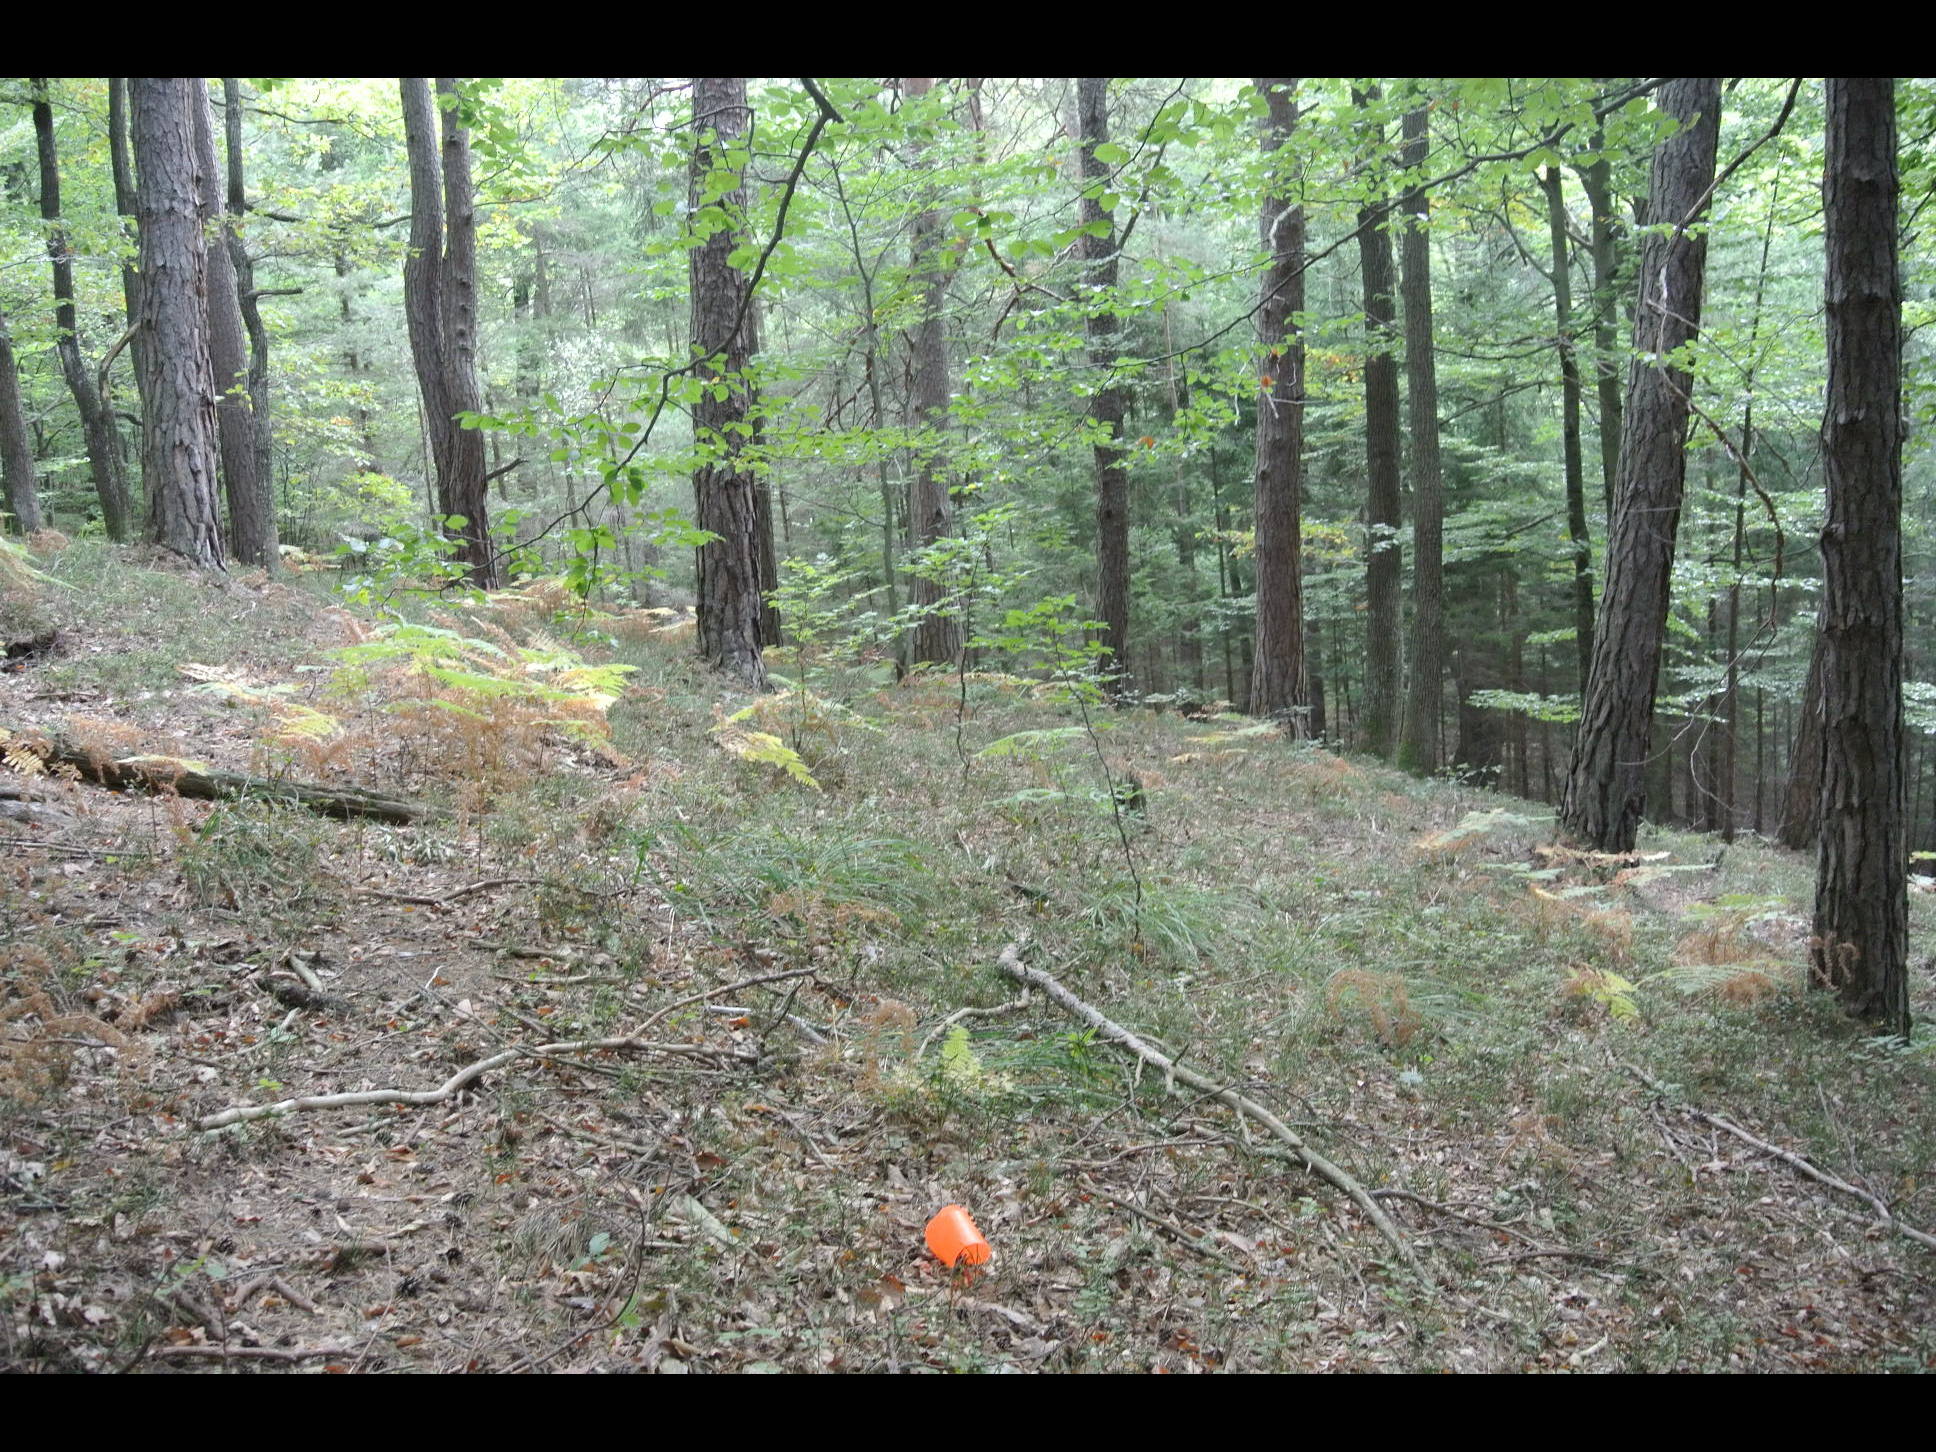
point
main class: Woodland
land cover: Pine dominated mixed woodland
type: alpine coniferous forest
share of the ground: > 75 %
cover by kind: coniferous forest trees 50 %, broadleaved forest trees 50 %
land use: Forestry
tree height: > 5 m
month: September
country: AT
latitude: 47.3876
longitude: 16.4015
